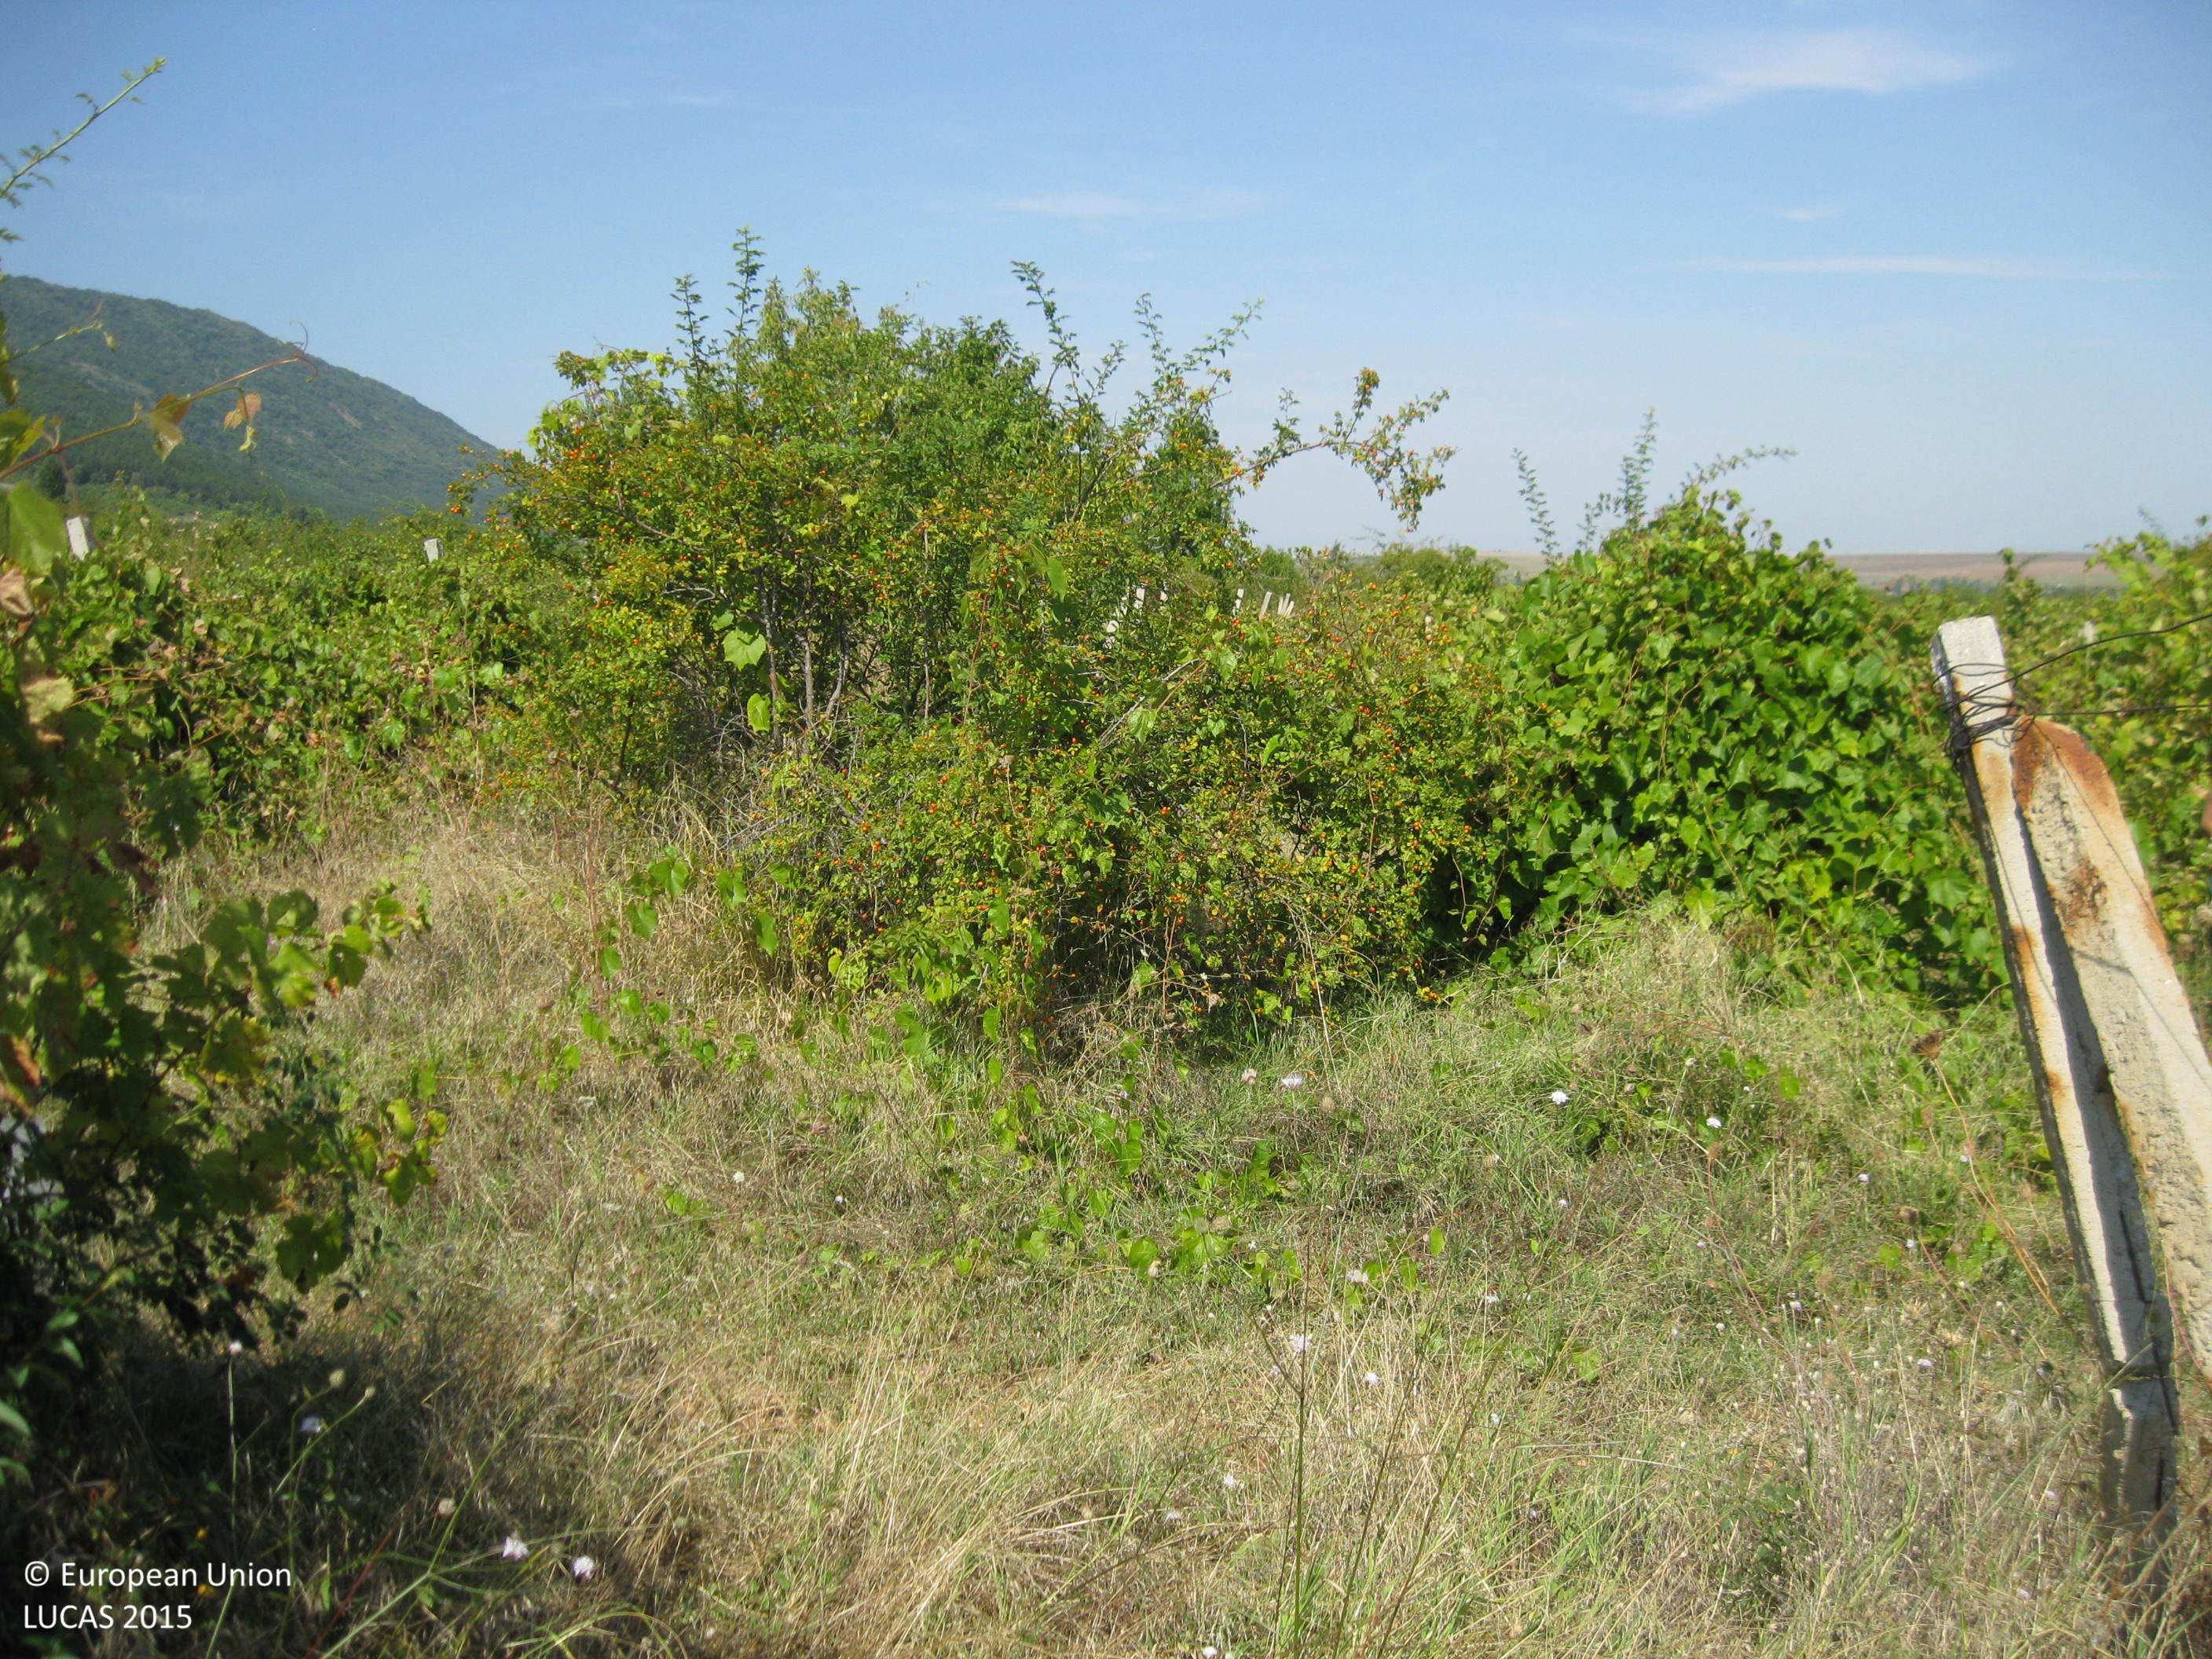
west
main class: Cropland
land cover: Vineyards
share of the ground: 25 - 50 %
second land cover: Spontaneously vegetated surfaces
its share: > 75 %
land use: Agriculture (excluding fallow land and kitchen gardens)
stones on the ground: < 10 %
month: August
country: BG
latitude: 41.9798
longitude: 24.9339
